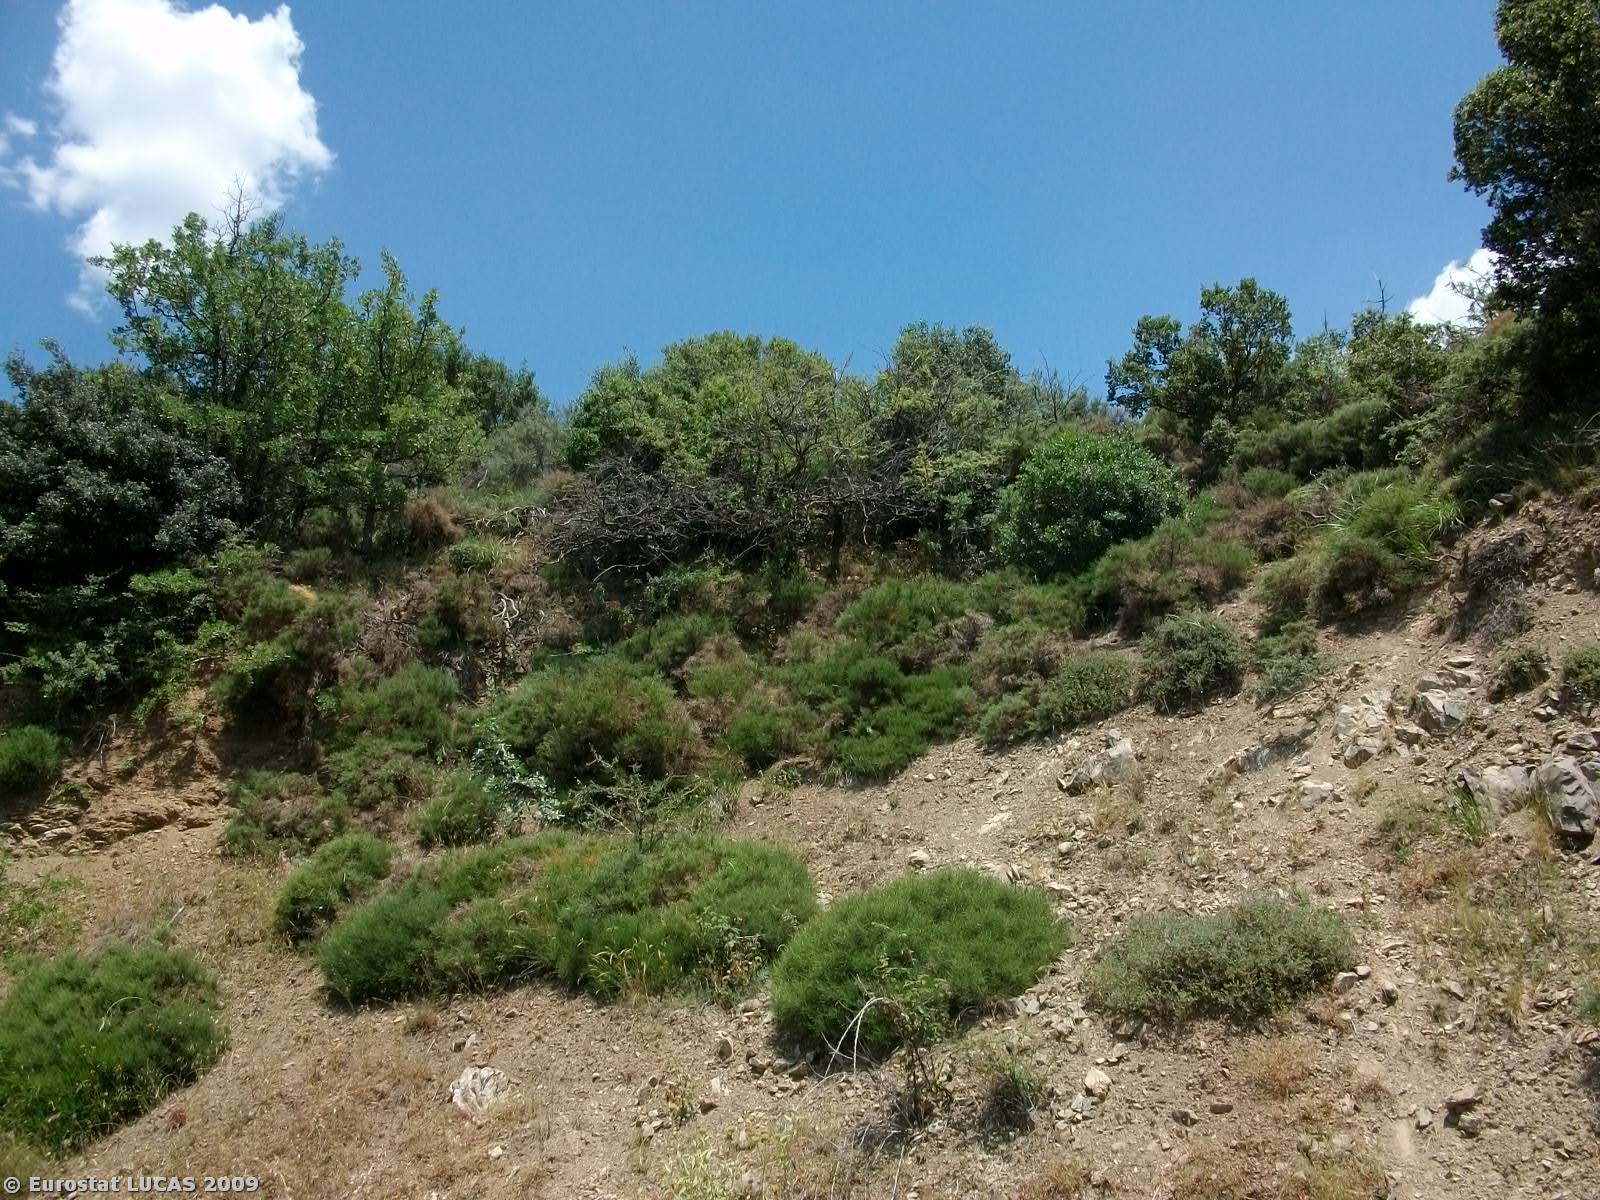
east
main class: Woodland
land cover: Broadleaved woodland
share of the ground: > 75 %
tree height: < 5 m
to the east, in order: Broadleaved woodland; Paved roads, cycling and walking lanes; Broadleaved woodland
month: June
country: GR
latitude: 37.1817
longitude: 22.1773
